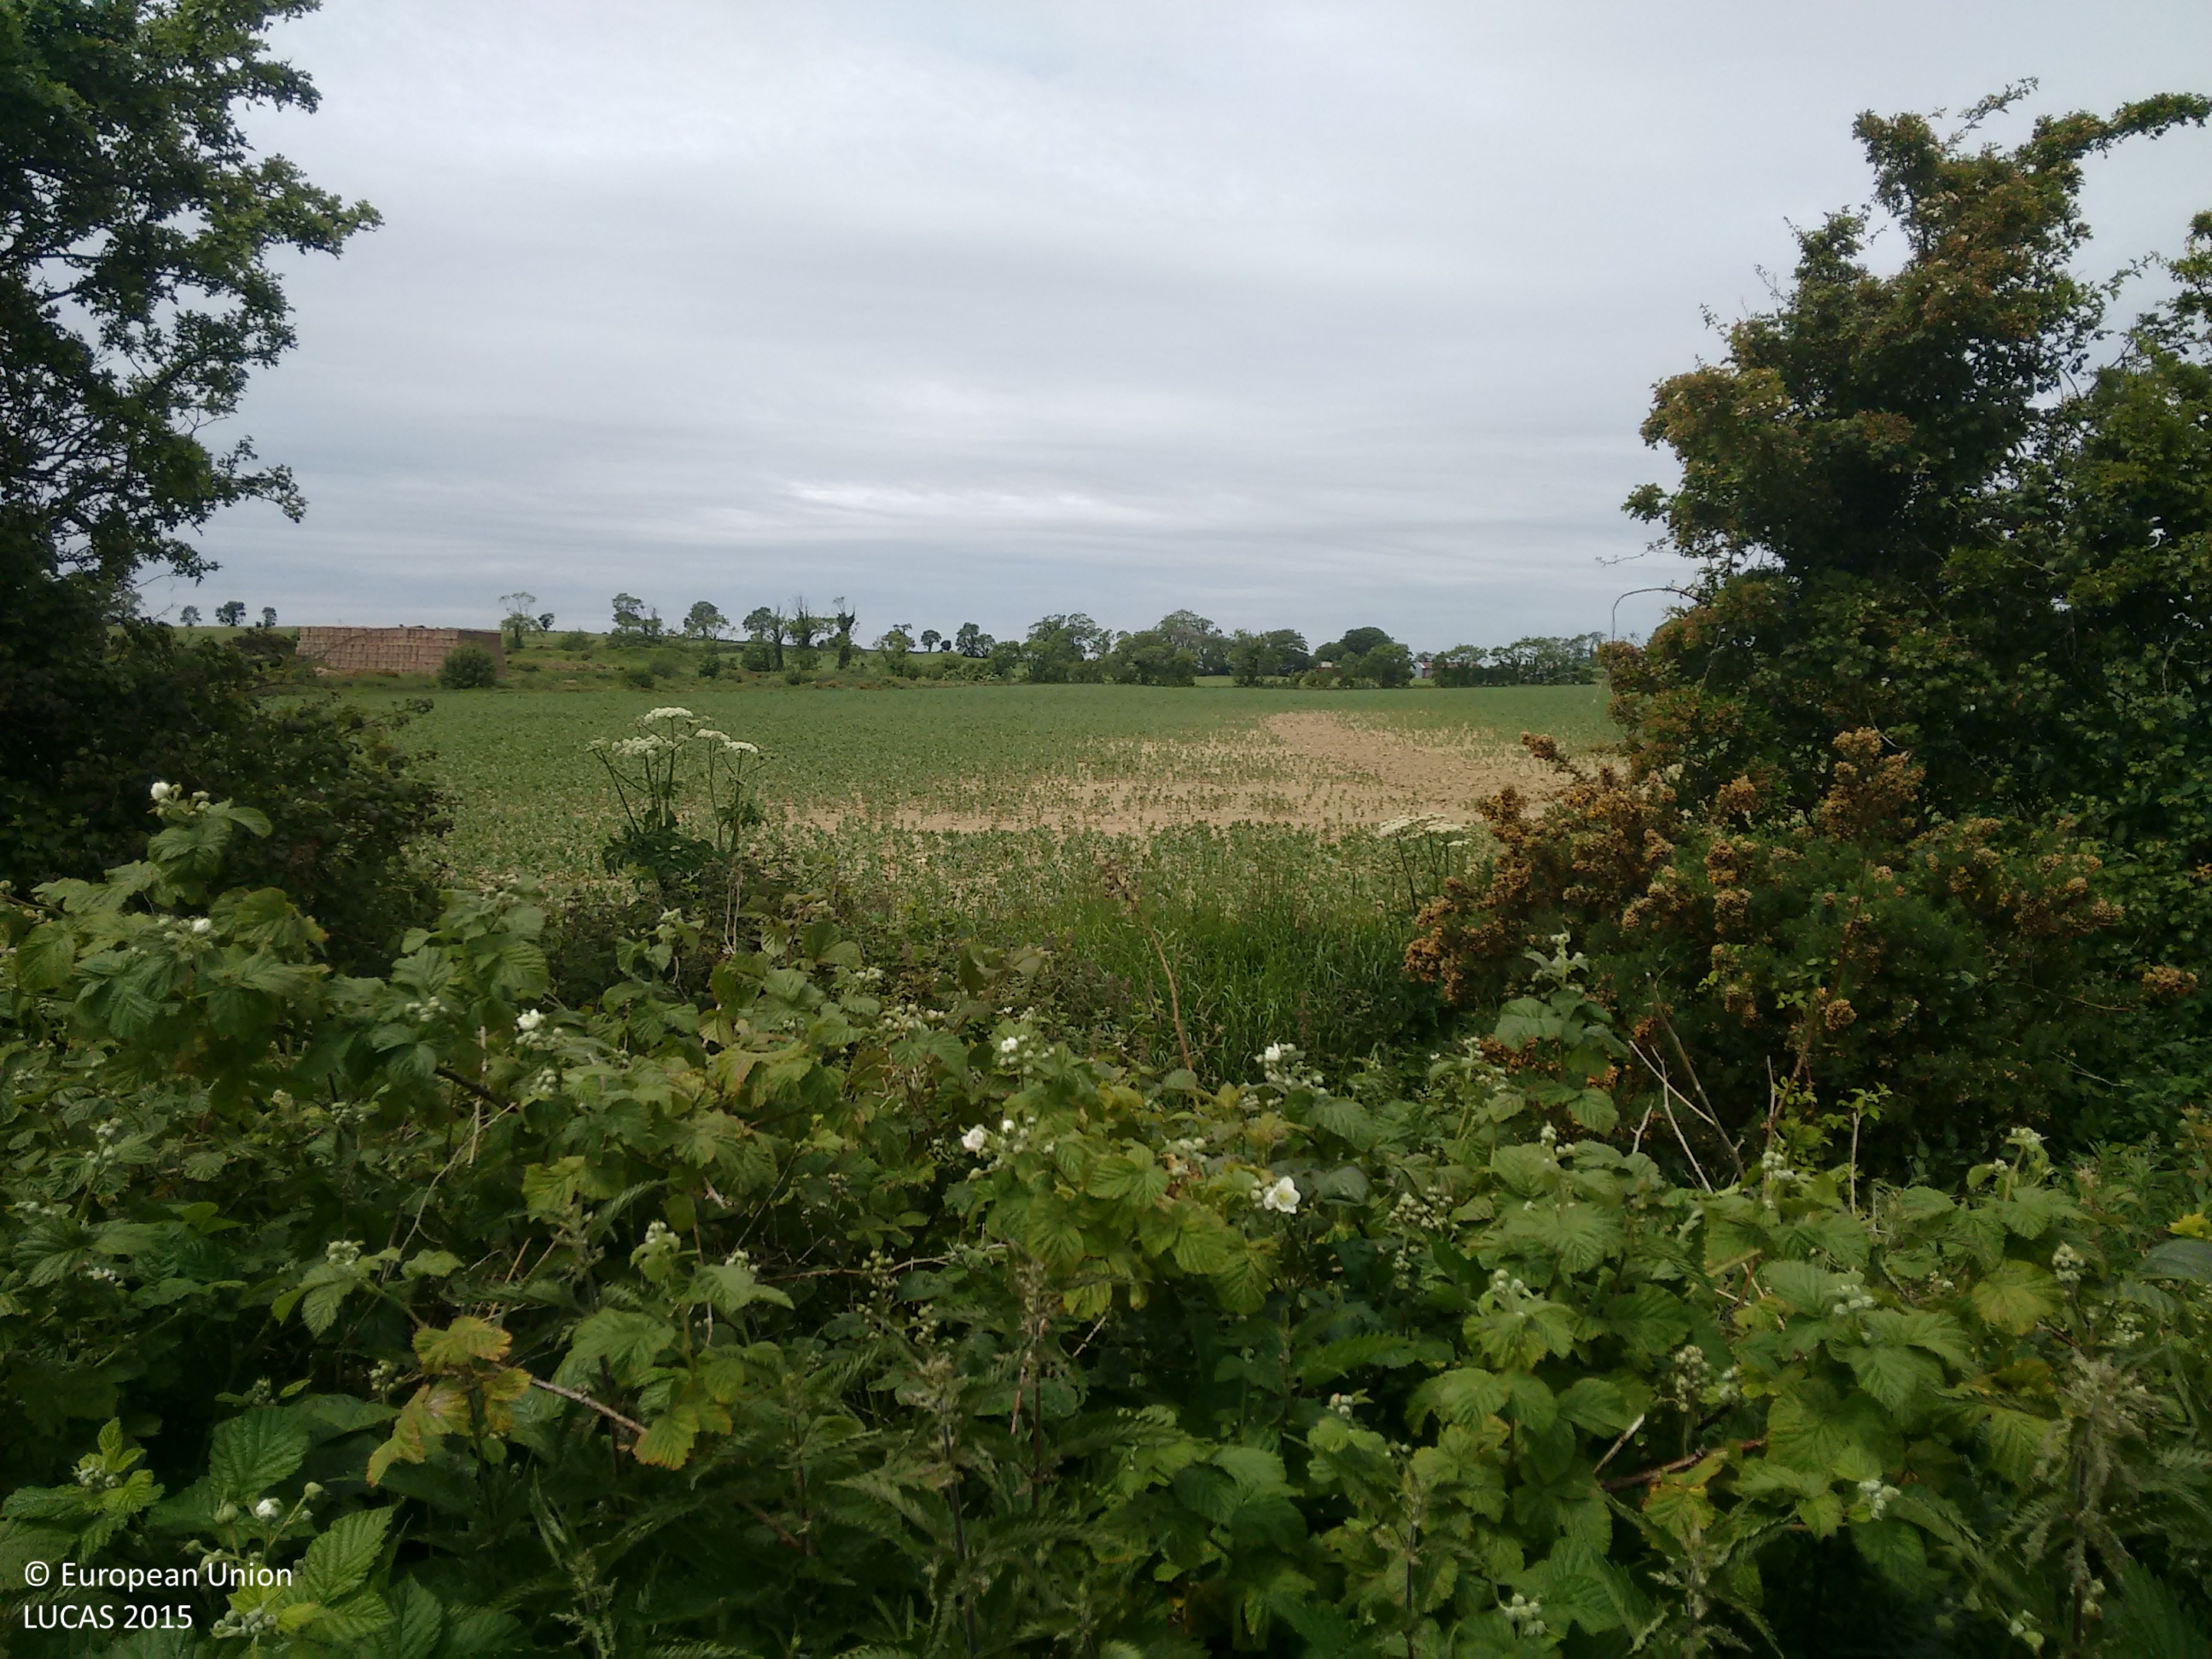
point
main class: Cropland
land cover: Other fresh vegetables
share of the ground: > 75 %
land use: Agriculture (excluding fallow land and kitchen gardens)
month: June
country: IE
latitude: 53.5718
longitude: -6.1693
